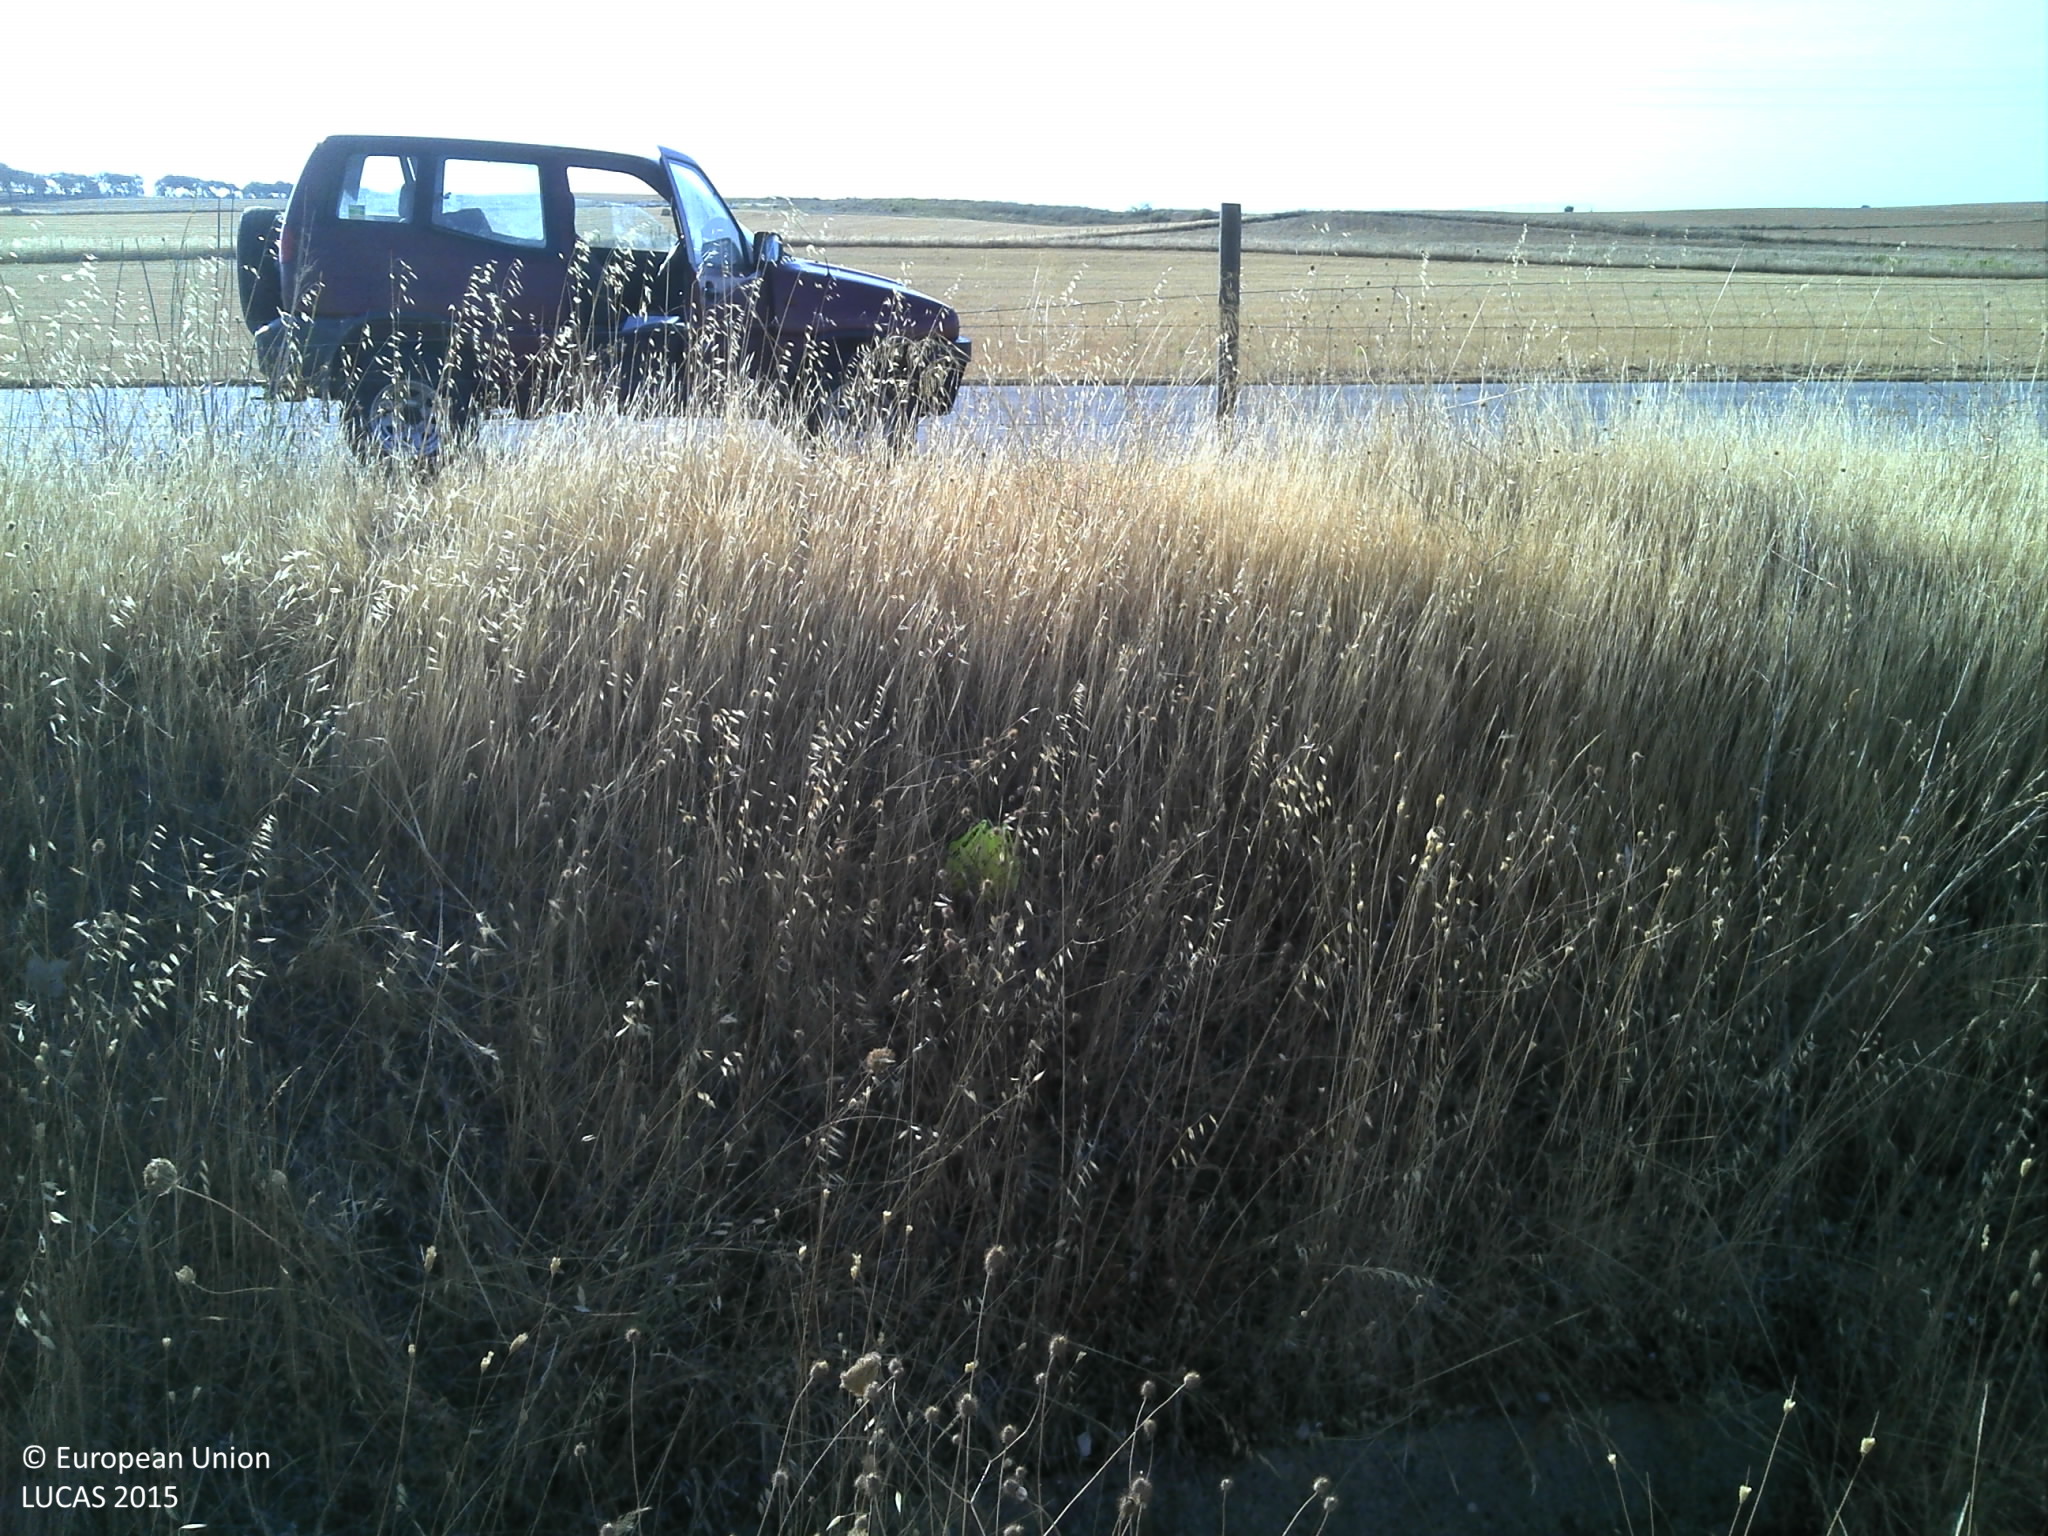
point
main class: Grassland
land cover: Grassland without tree/shrub cover
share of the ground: 50 - 75 %
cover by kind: herbaceous plants 70 %, unconsolidated bare surface 30 %
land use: Road transport
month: July
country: PT
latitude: 38.4870
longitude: -7.7464
